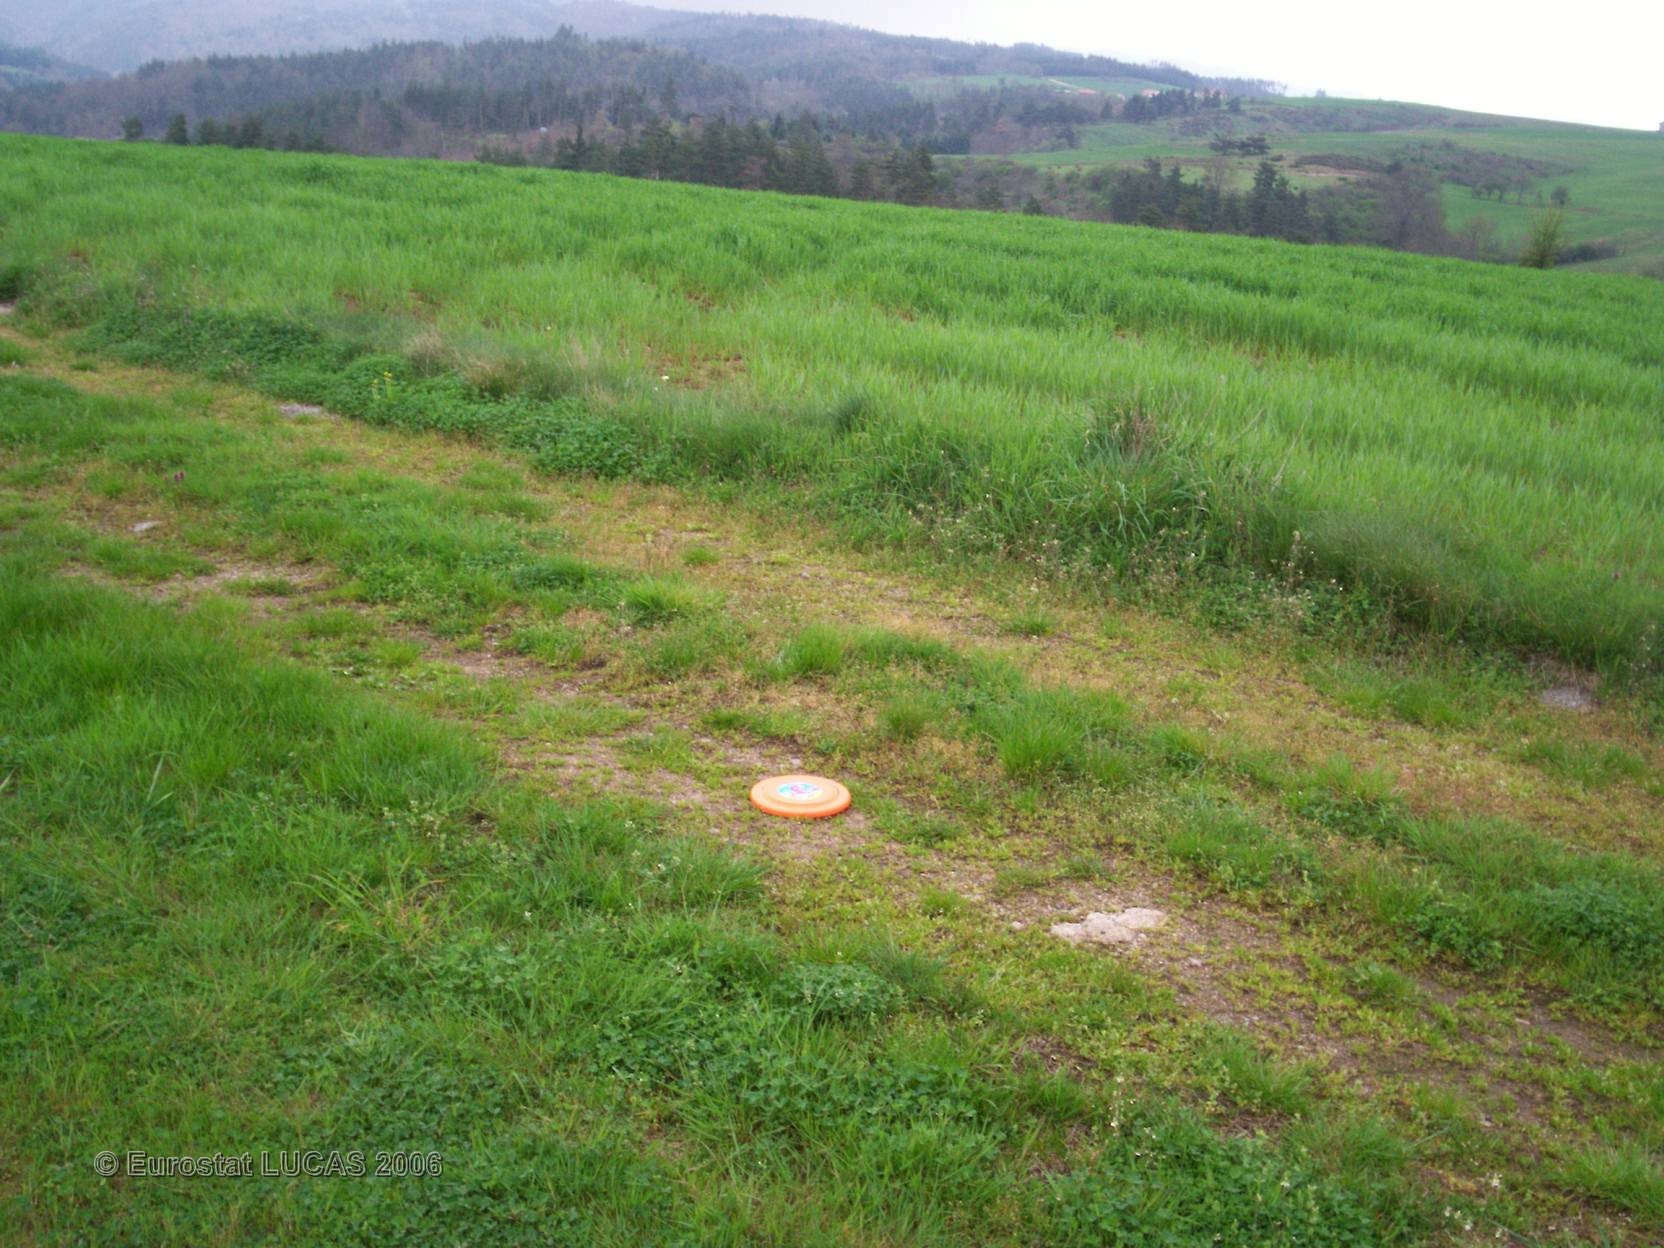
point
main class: Cropland
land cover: Rye
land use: Agriculture (excluding fallow land and kitchen gardens)
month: April
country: FR
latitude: 45.3434
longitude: 4.1714
